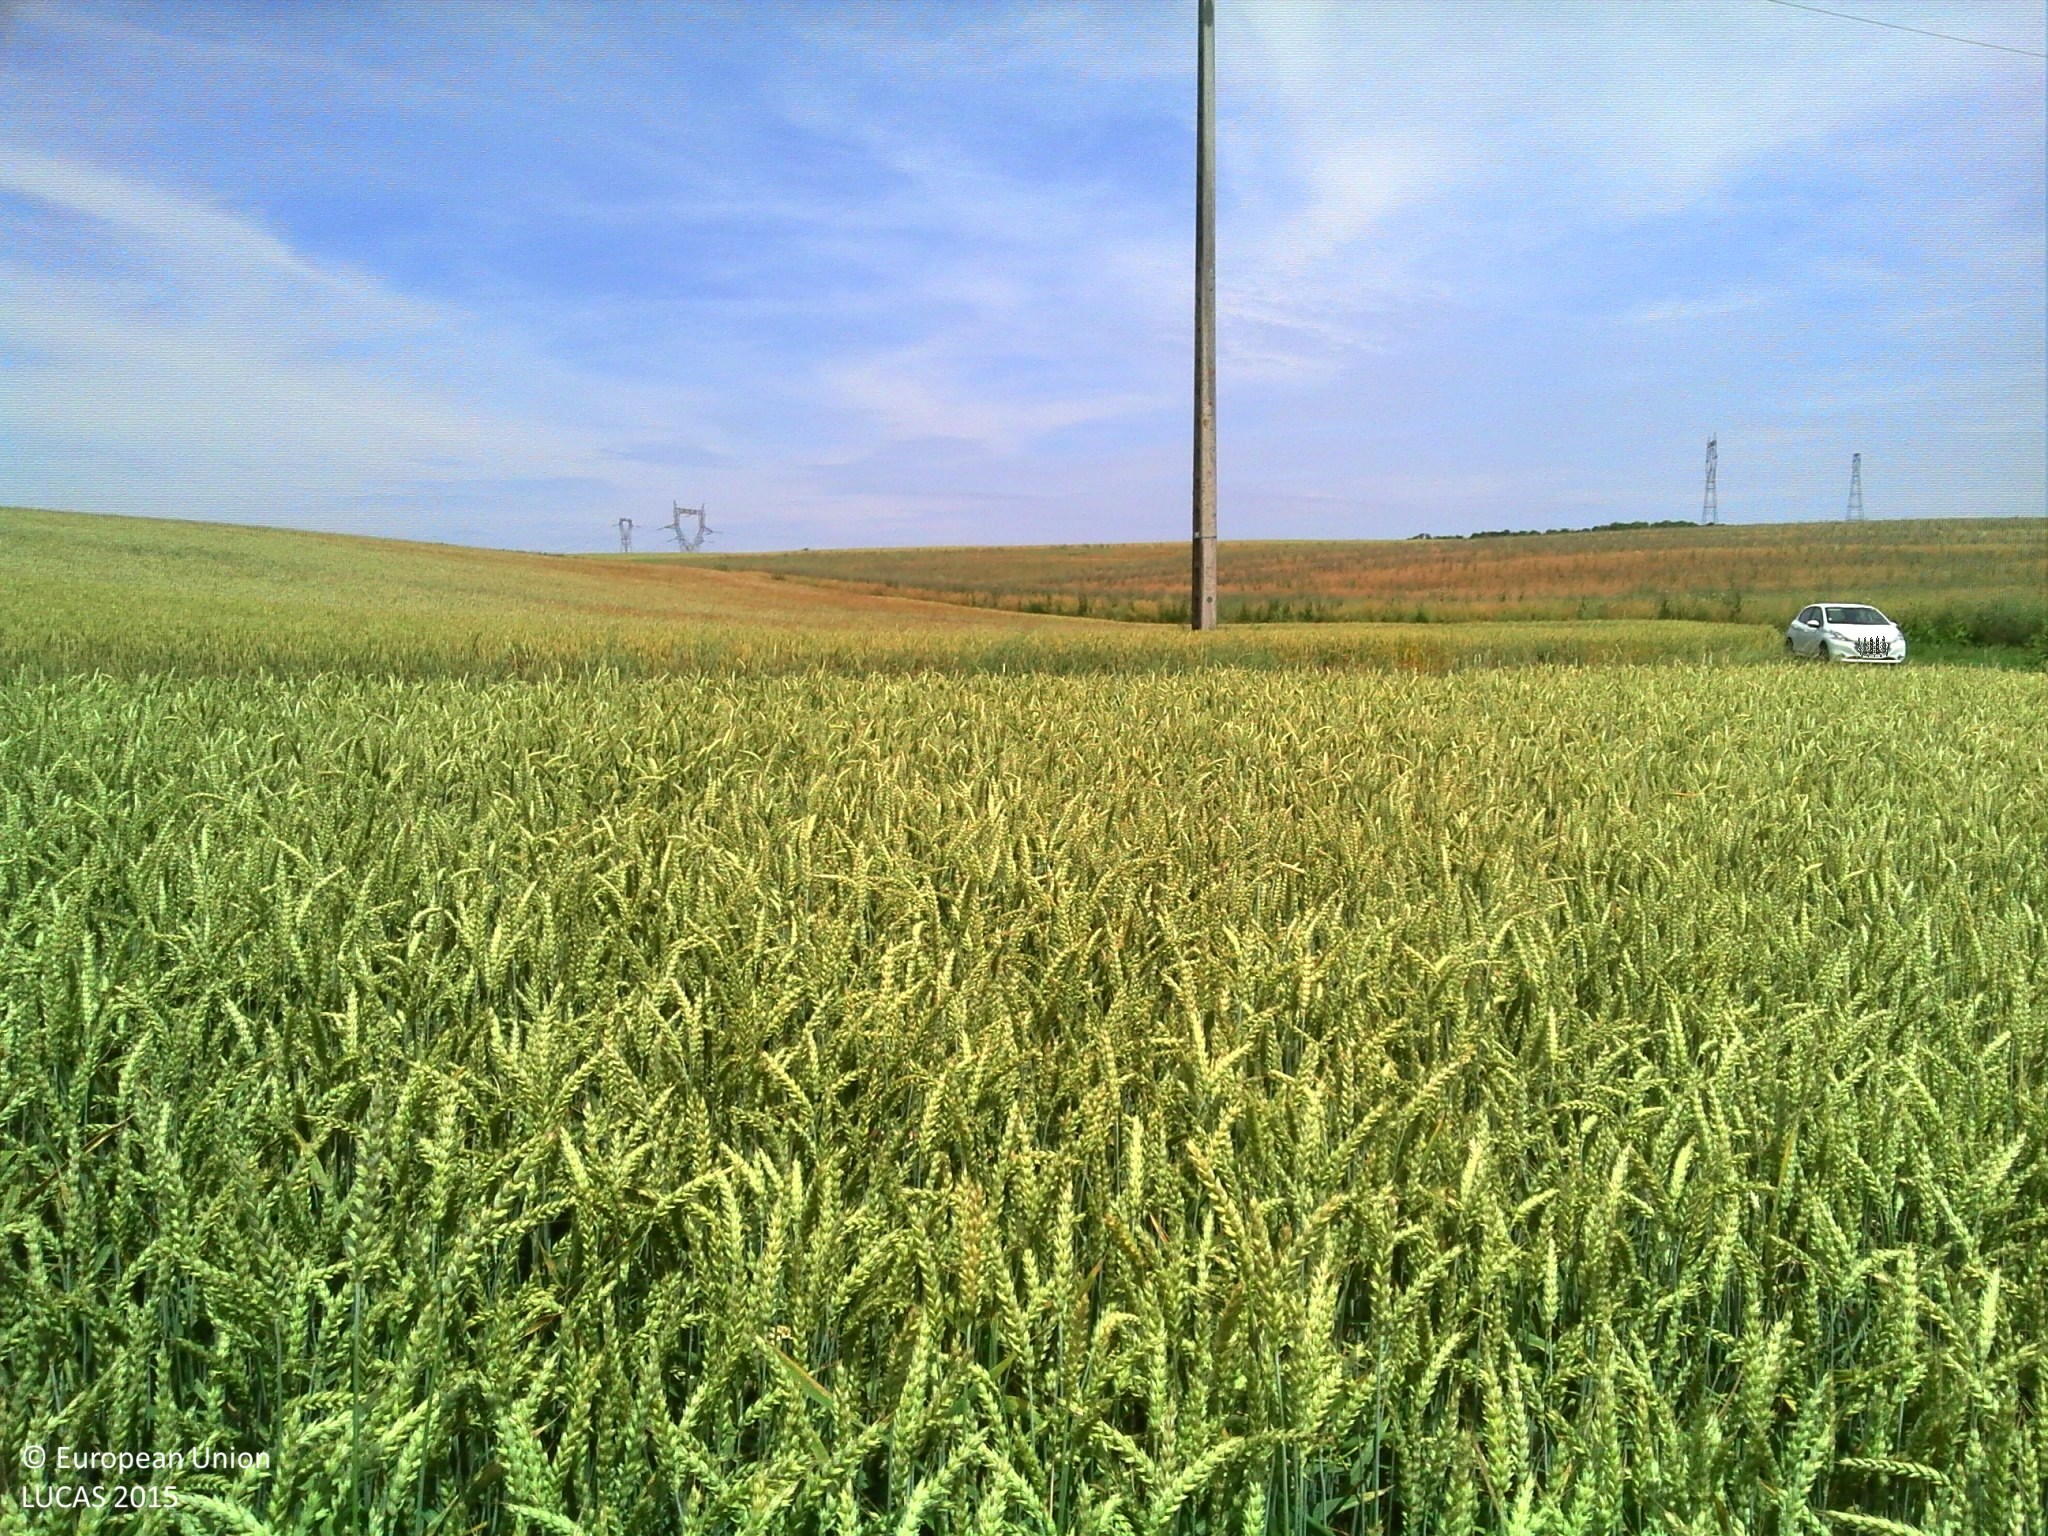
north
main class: Cropland
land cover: Common wheat
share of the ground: > 75 %
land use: Agriculture (excluding fallow land and kitchen gardens)
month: June
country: FR
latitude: 48.4104
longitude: 6.2040
